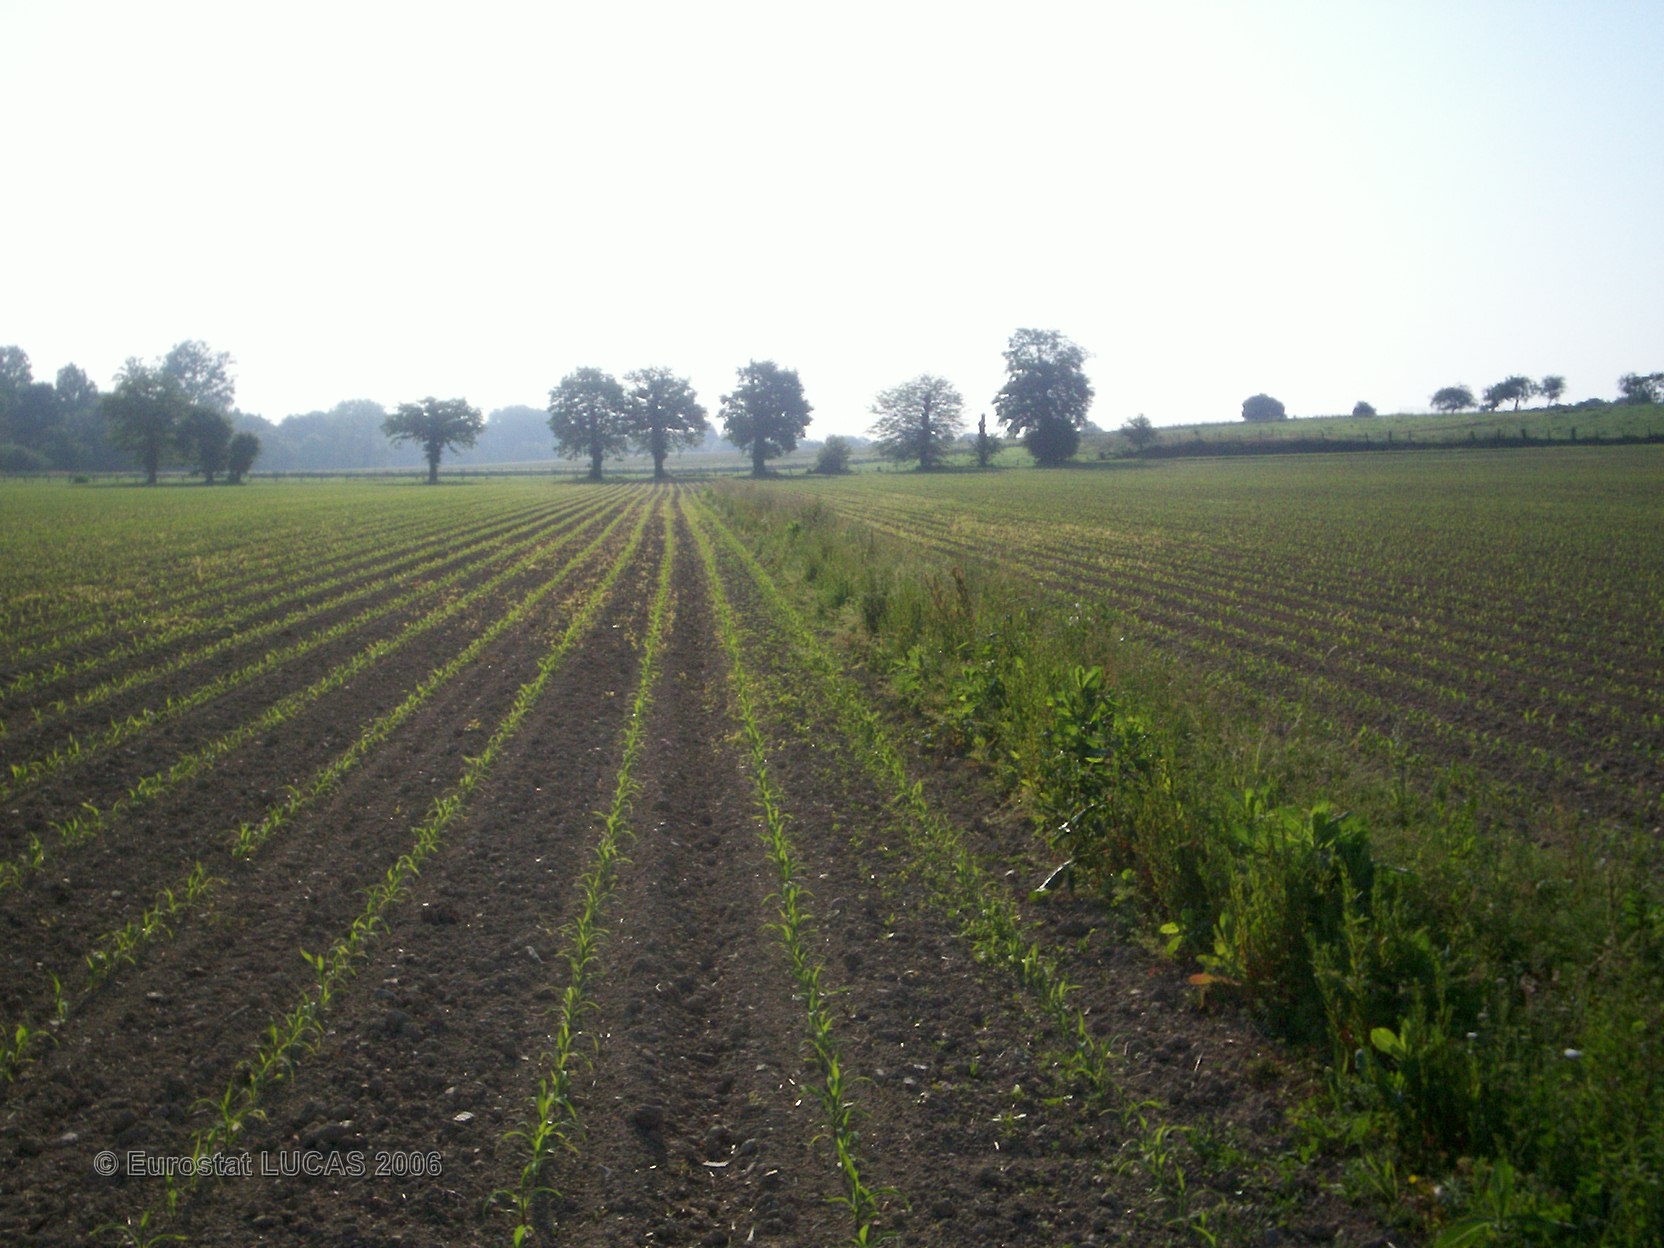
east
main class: Cropland
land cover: Maize
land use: Agriculture (excluding fallow land and kitchen gardens)
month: June
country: FR
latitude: 48.0277
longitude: -1.5923
